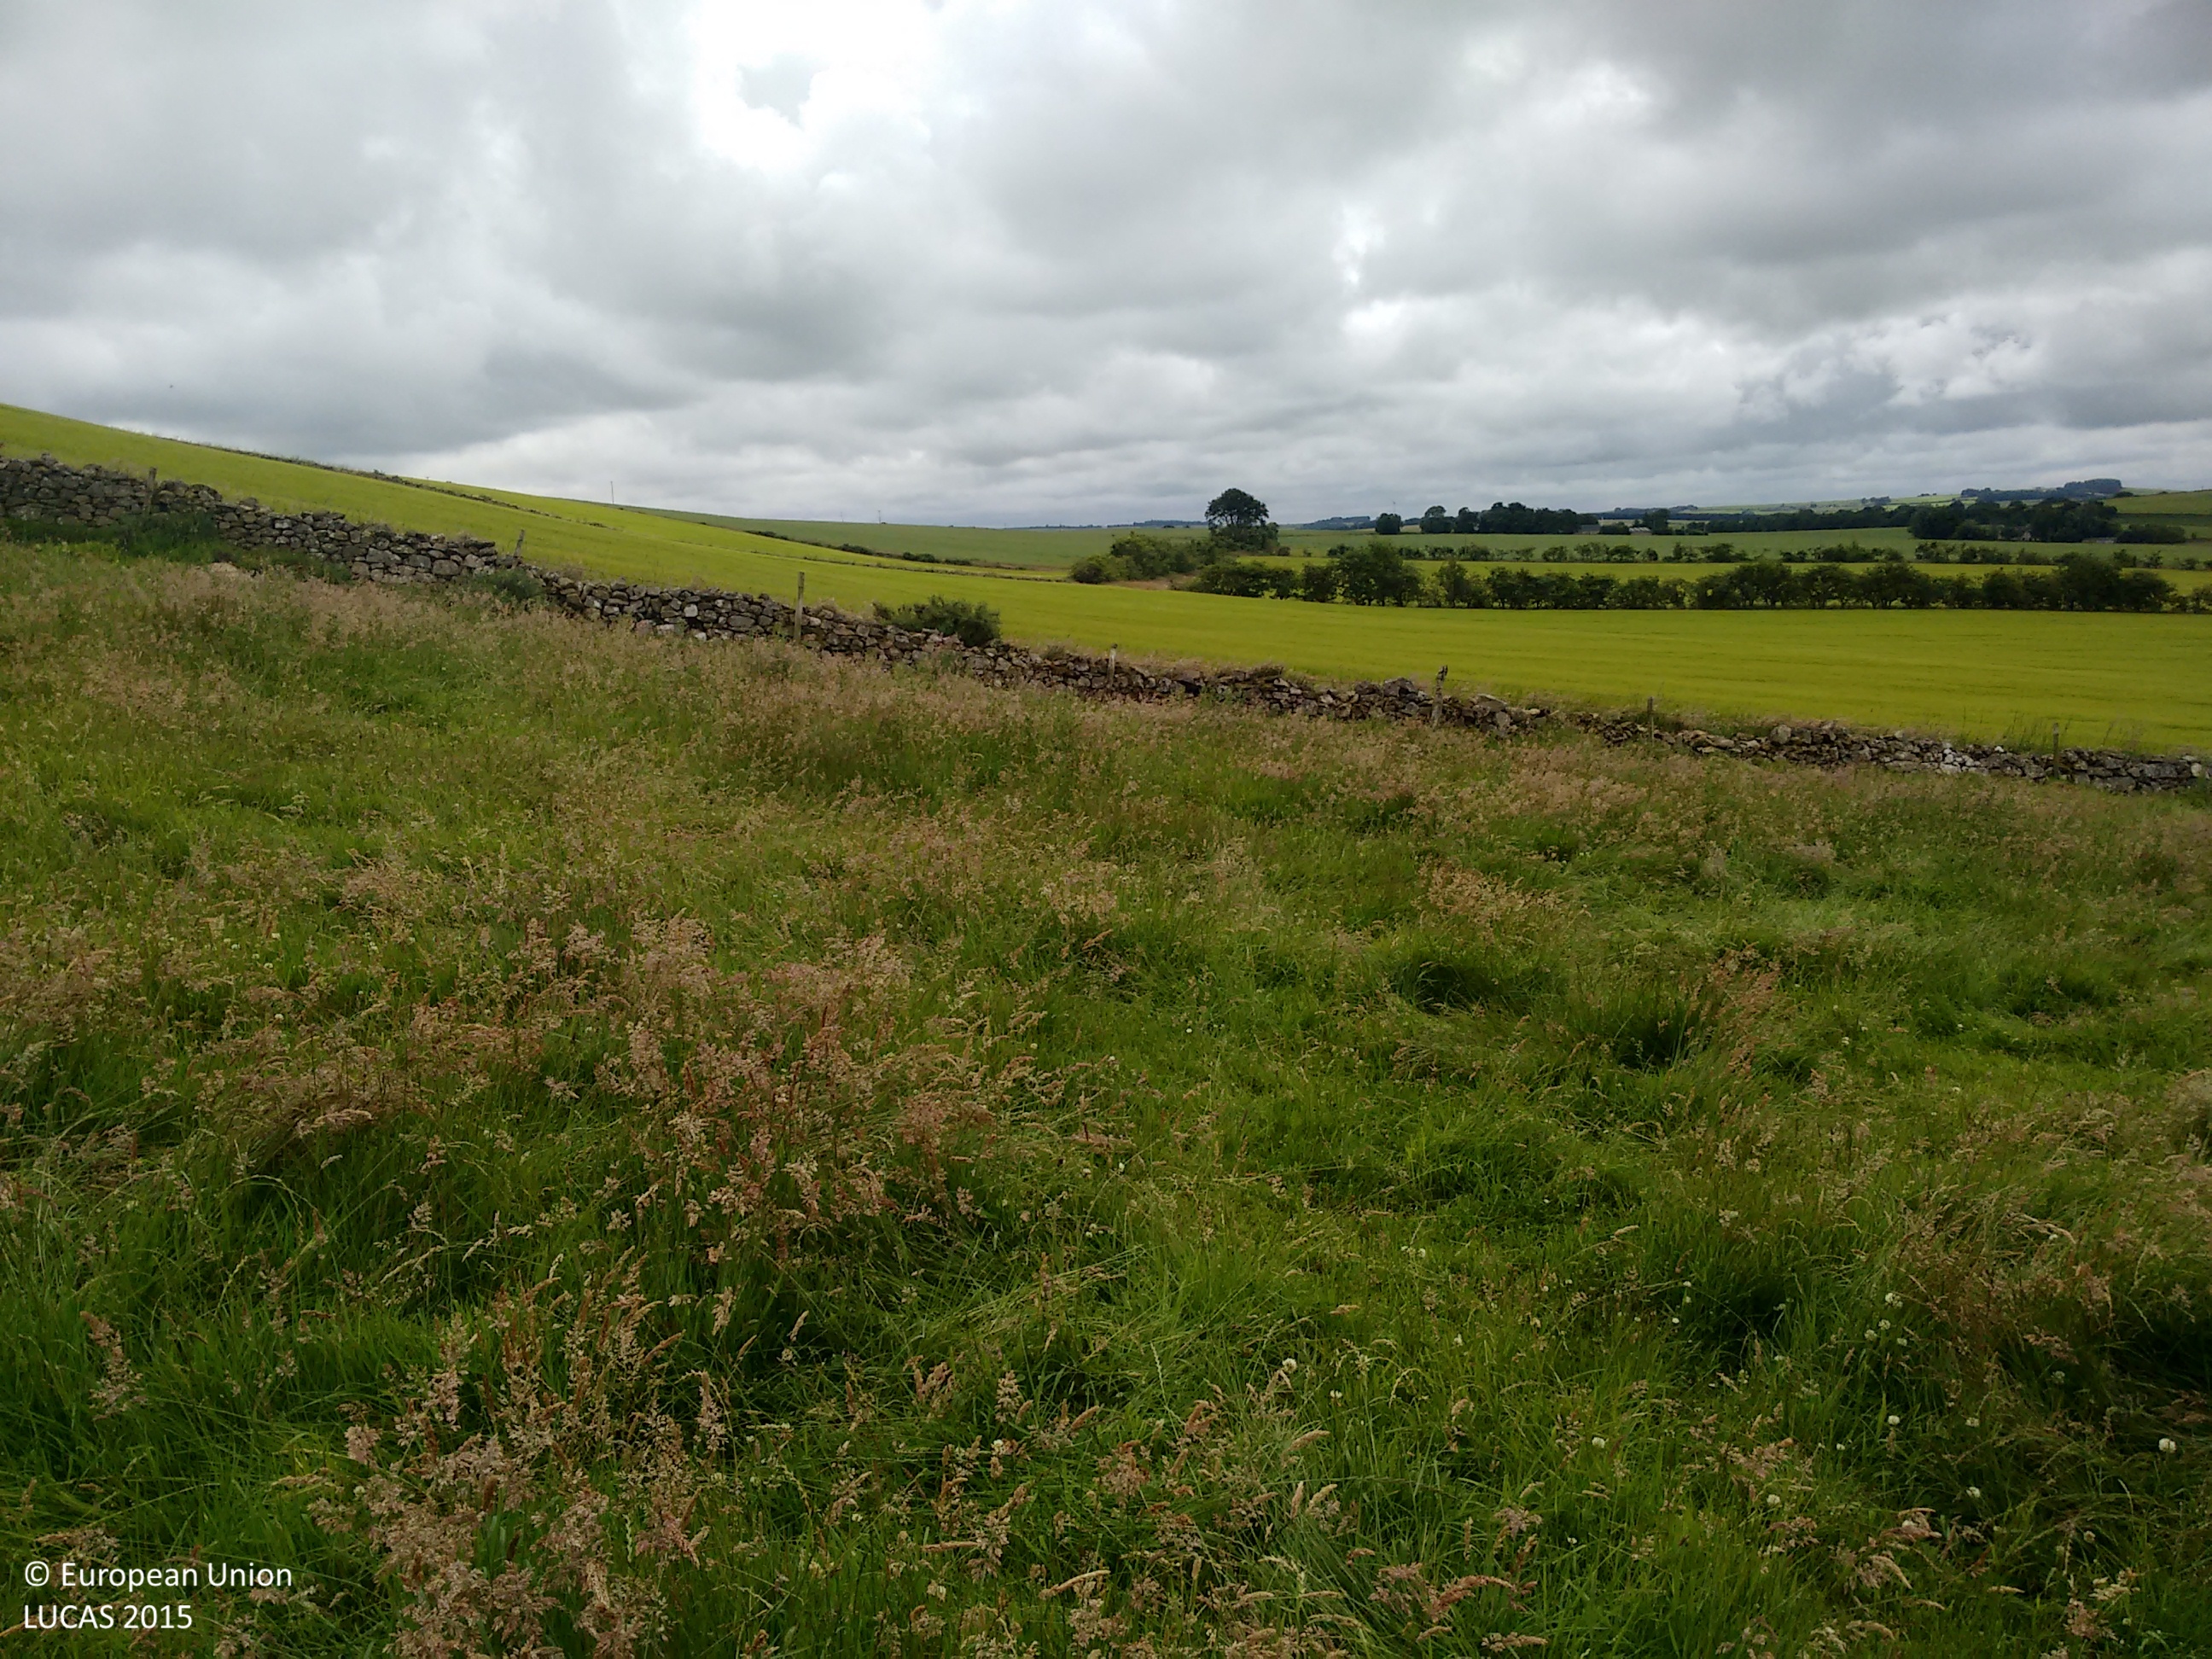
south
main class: Grassland
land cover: Grassland without tree/shrub cover
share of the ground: > 75 %
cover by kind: herbaceous plants 100 %
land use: Agriculture (excluding fallow land and kitchen gardens)
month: July
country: GB
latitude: 57.3486
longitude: -2.2305
